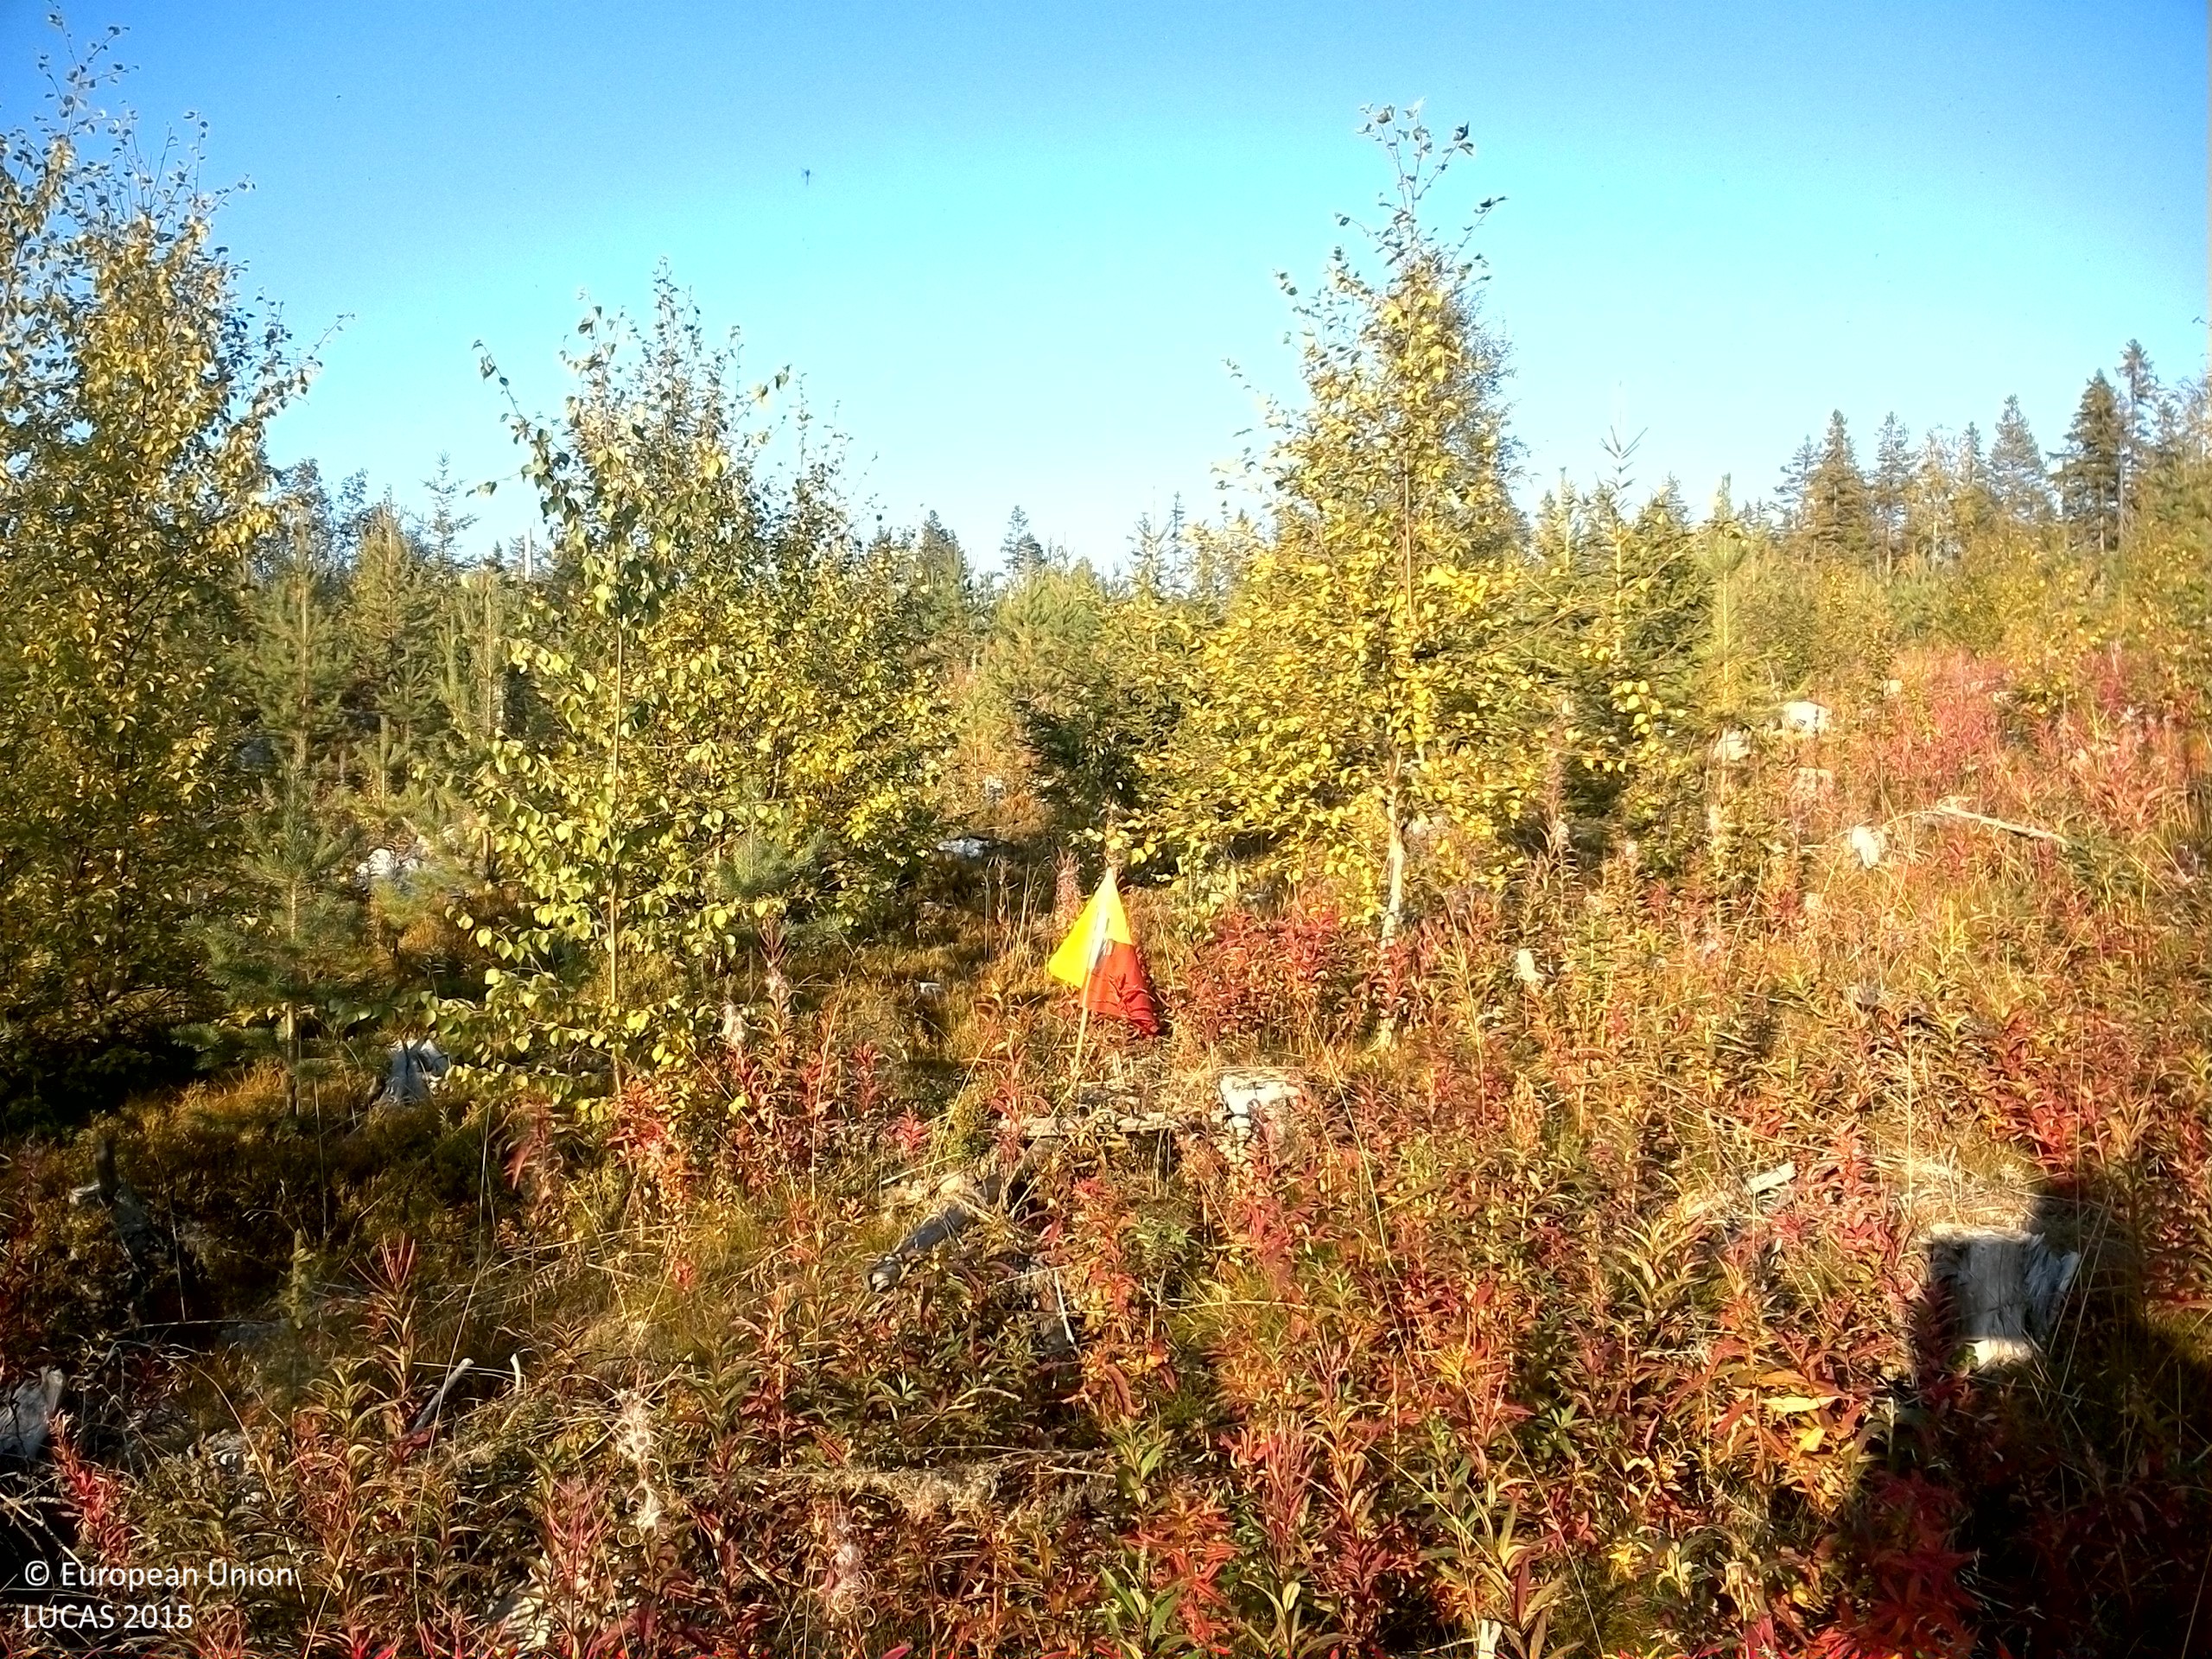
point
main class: Woodland
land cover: Pine dominated mixed woodland
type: boreal forest
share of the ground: 25 - 50 %
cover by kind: shrubs 40 %, coniferous forest trees 25 %, broadleaved forest trees 15 %, herbaceous plants 10 %, lichens and mosses 10 %
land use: Forestry
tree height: < 5 m
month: September
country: SE
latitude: 63.8987
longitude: 16.5923
